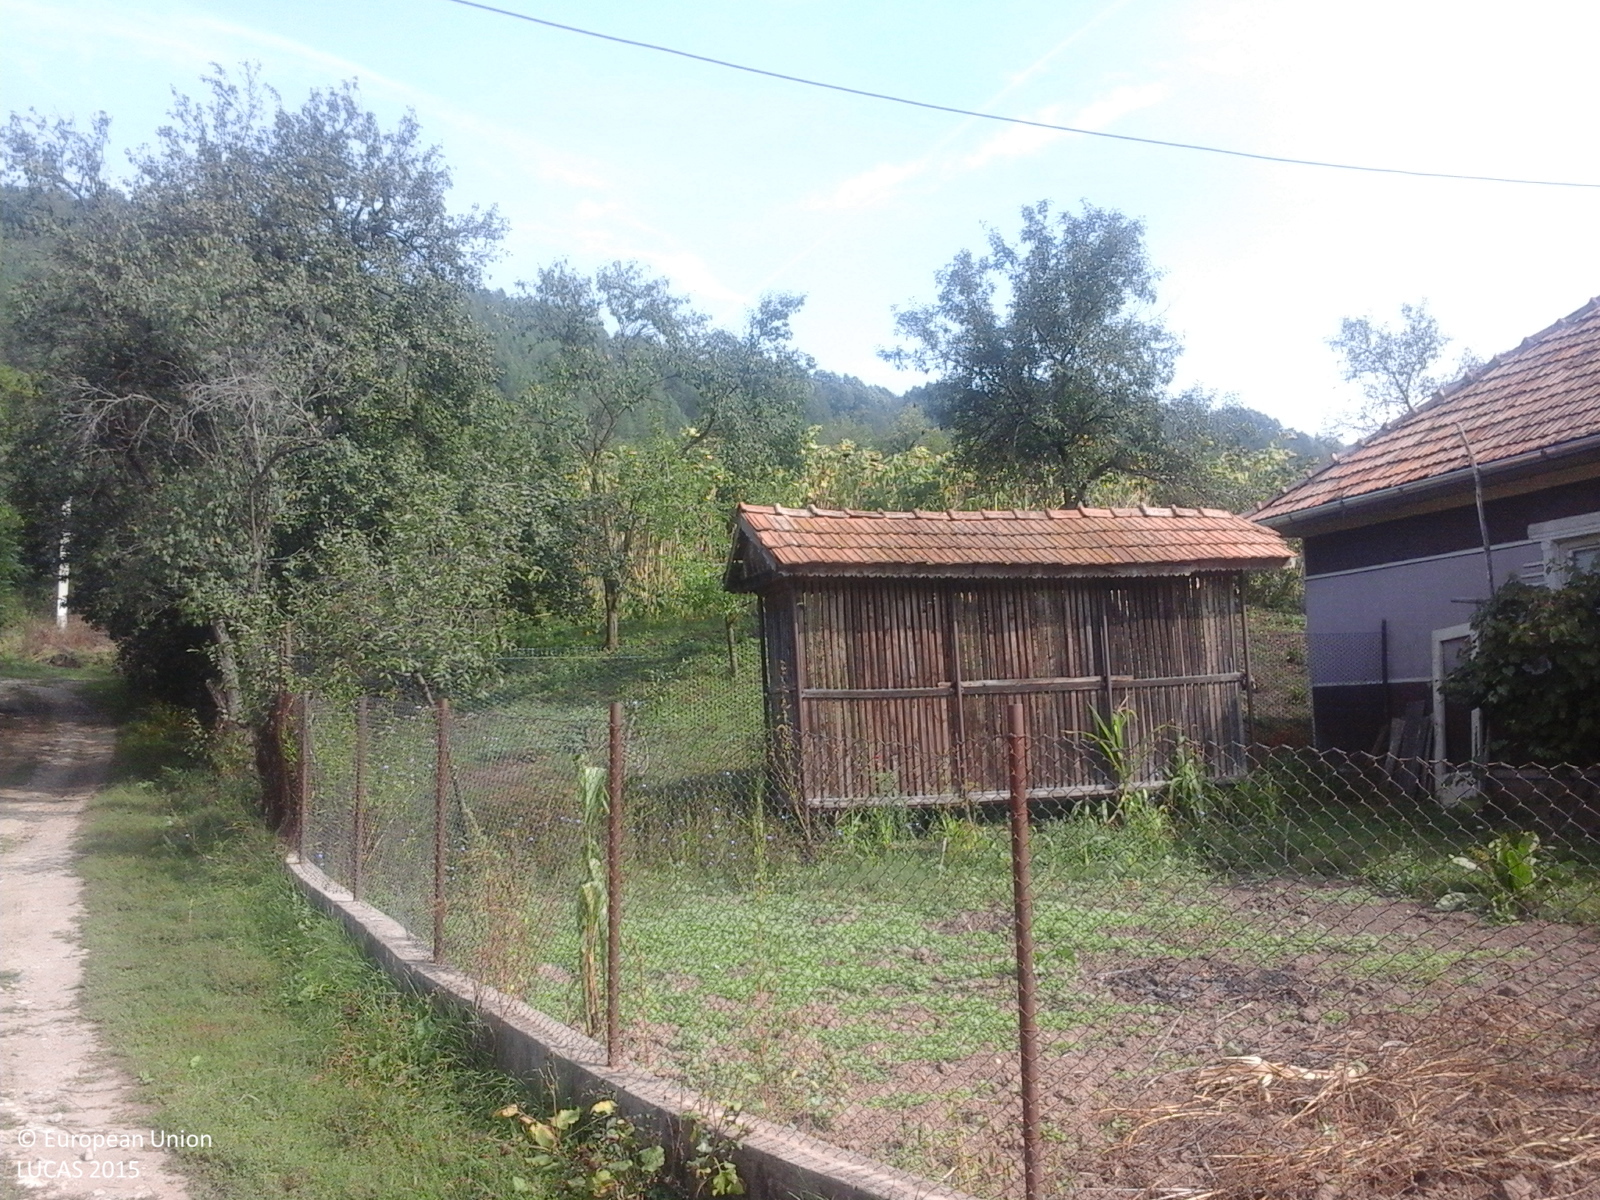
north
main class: Cropland
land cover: Maize
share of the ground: > 75 %
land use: Kitchen garden
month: September
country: RO
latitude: 47.1052
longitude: 23.2842
